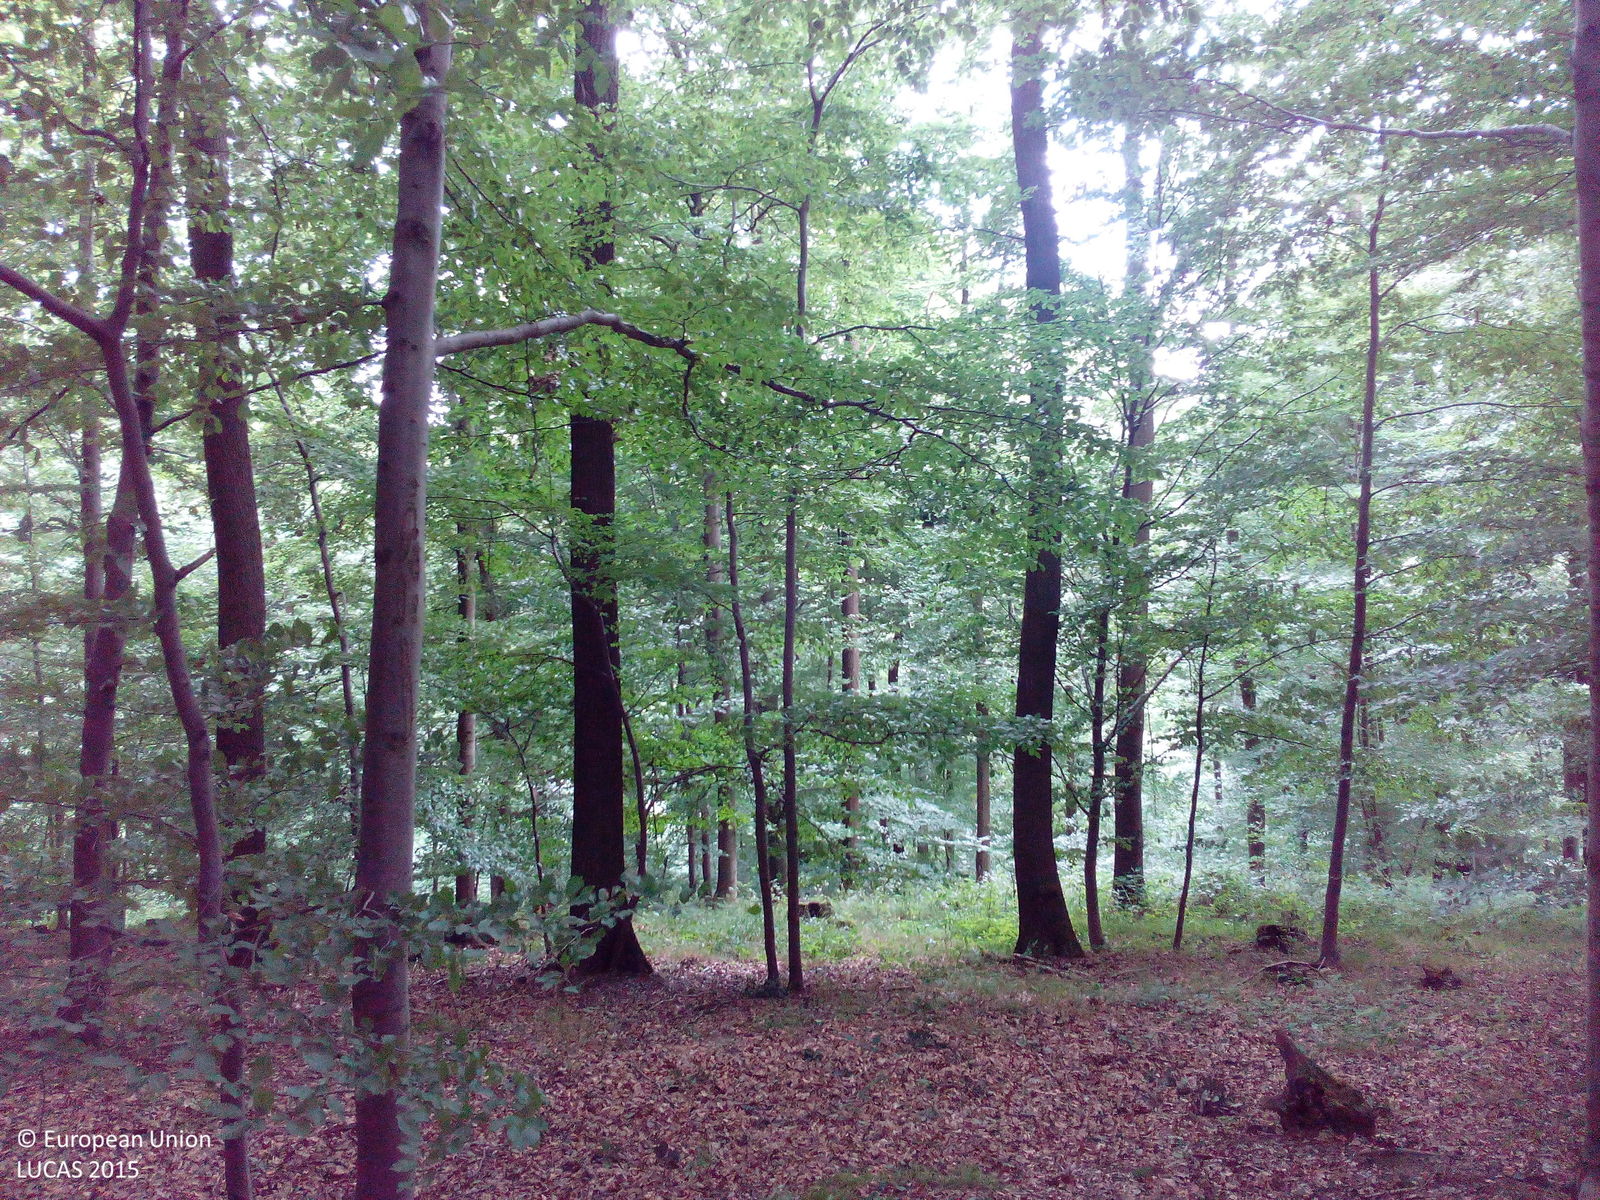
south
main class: Woodland
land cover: Broadleaved woodland
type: beech forest
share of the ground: > 75 %
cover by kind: broadleaved forest trees 100 %
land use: Forestry
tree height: > 5 m
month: July
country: DE
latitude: 51.7843
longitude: 9.9565
